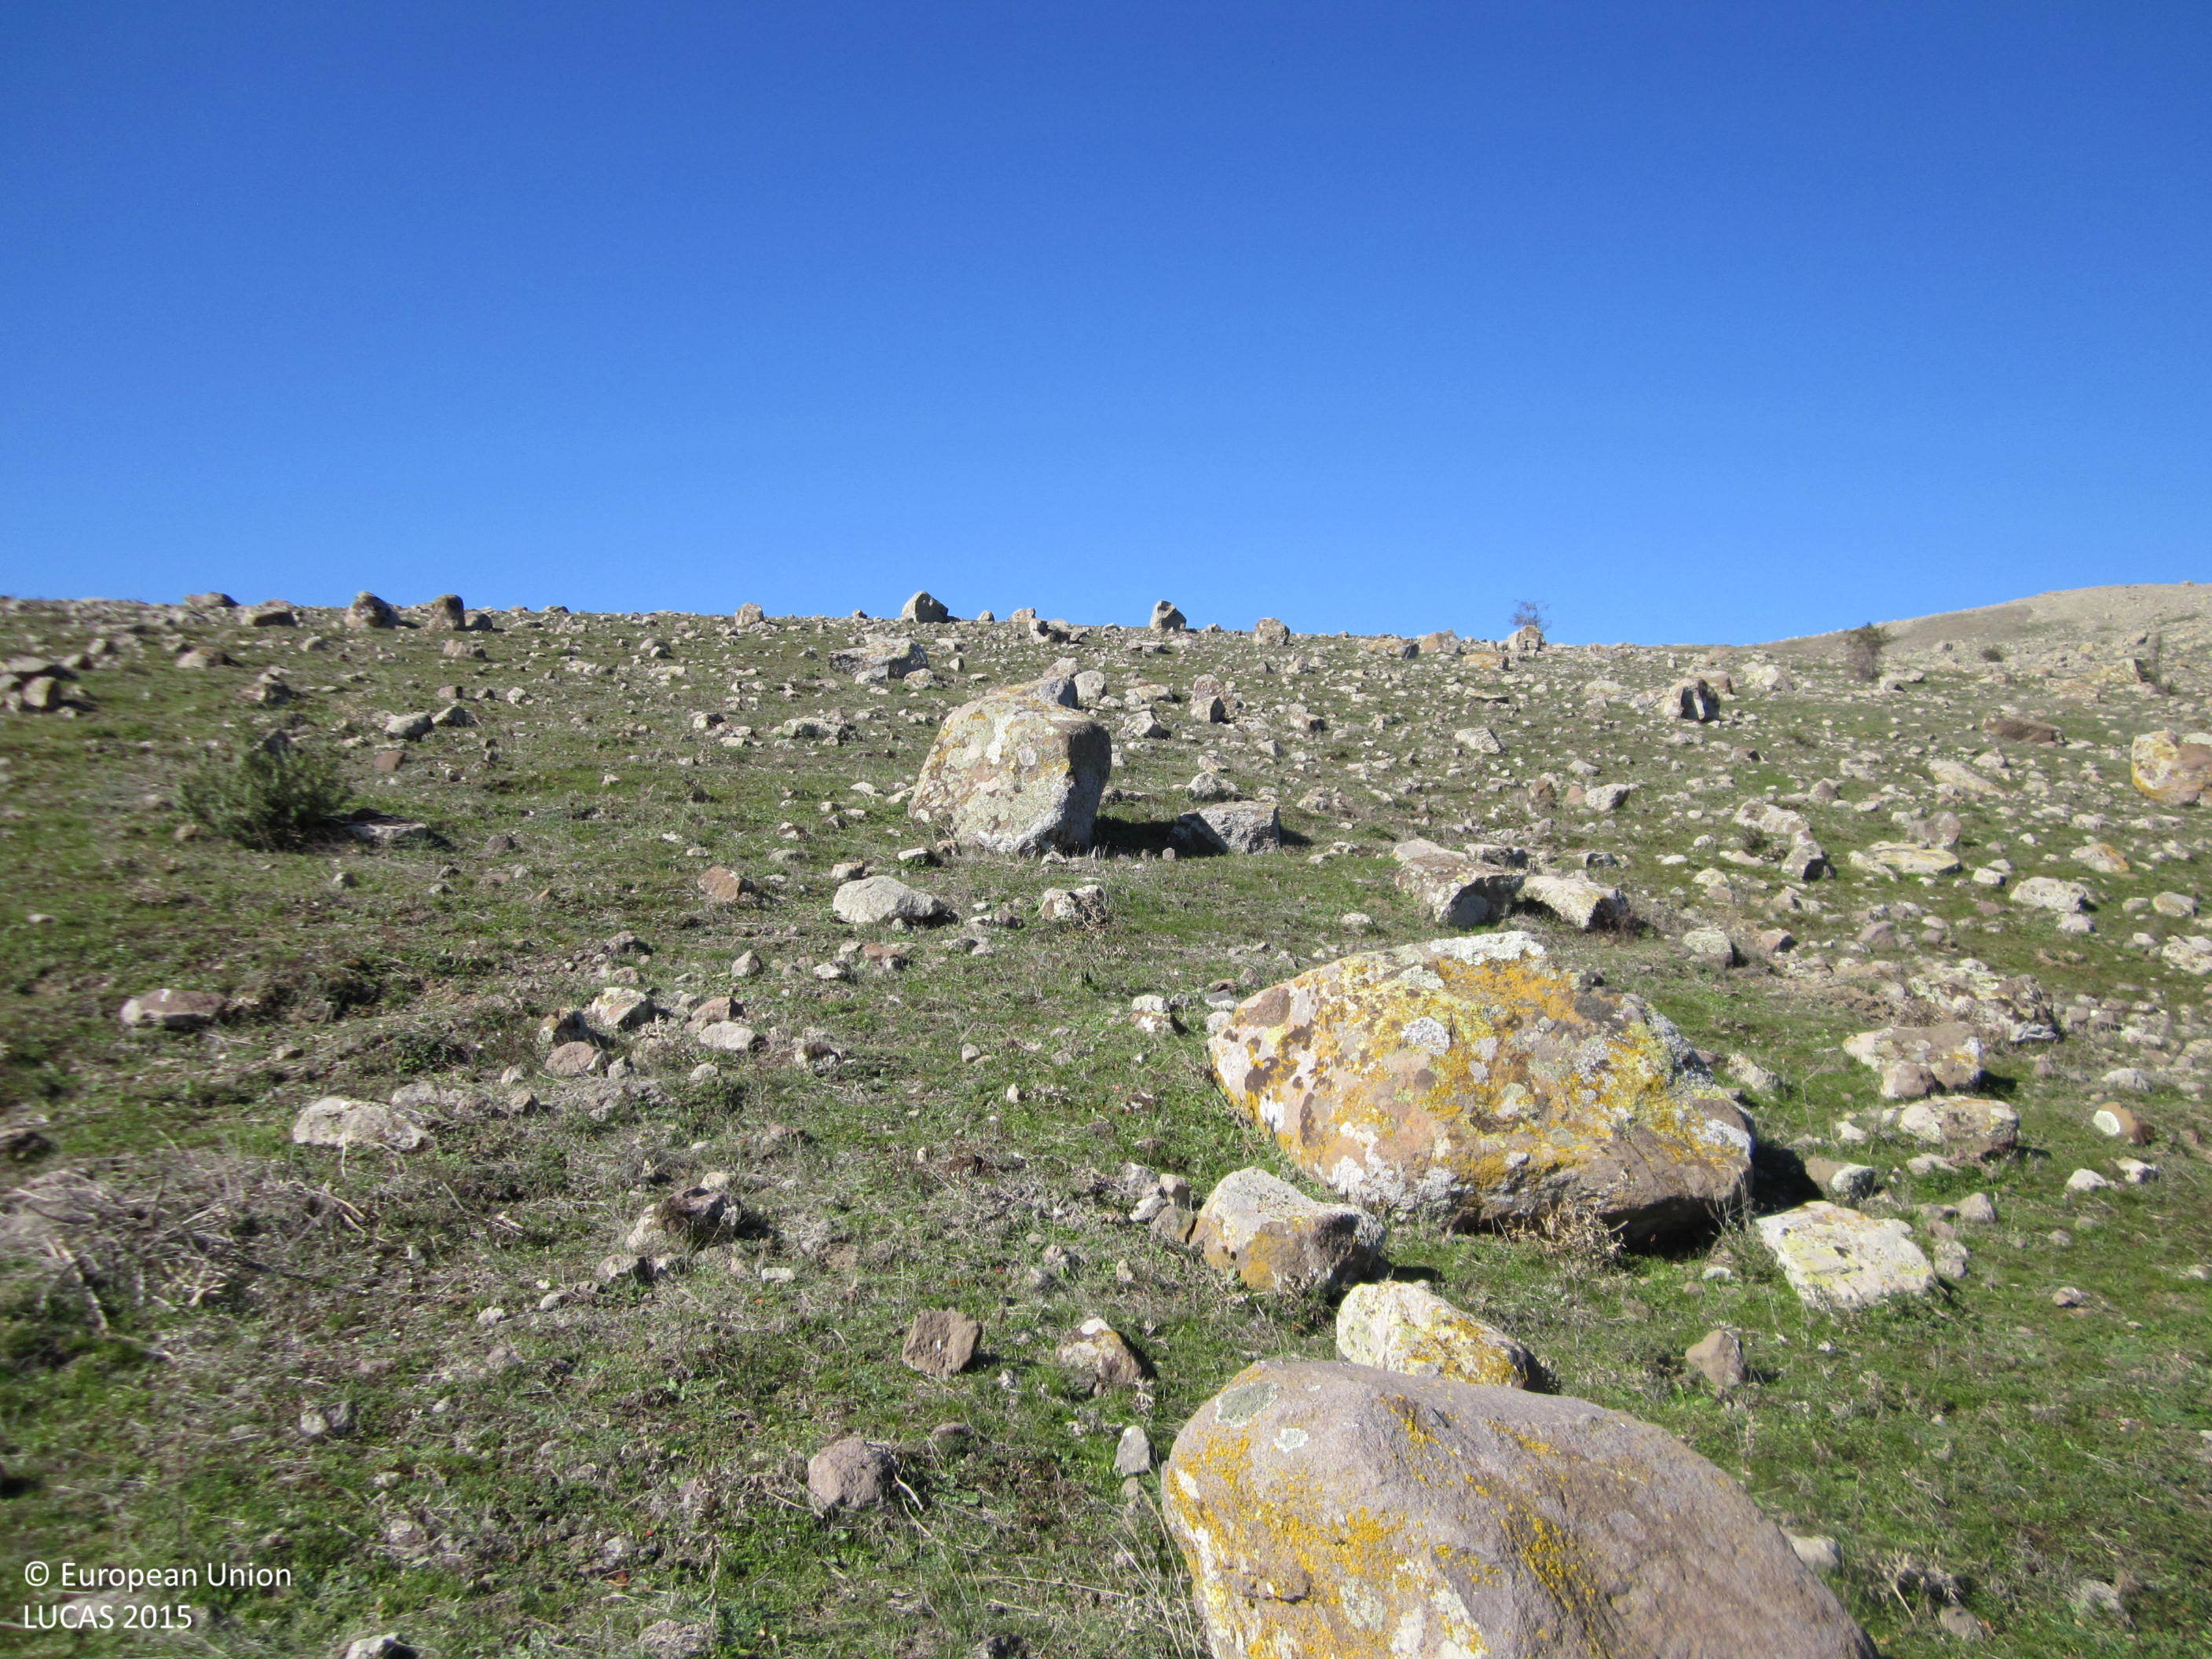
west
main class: Grassland
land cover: Grassland with sparse tree/shrub cover
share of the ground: > 75 %
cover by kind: herbaceous plants 70 %, unconsolidated bare surface 20 %, broadleaved forest trees 5 %, shrubs 5 %
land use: Semi-natural and natural areas not in use
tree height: < 5 m
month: November
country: BG
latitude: 41.4739
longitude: 25.7123
